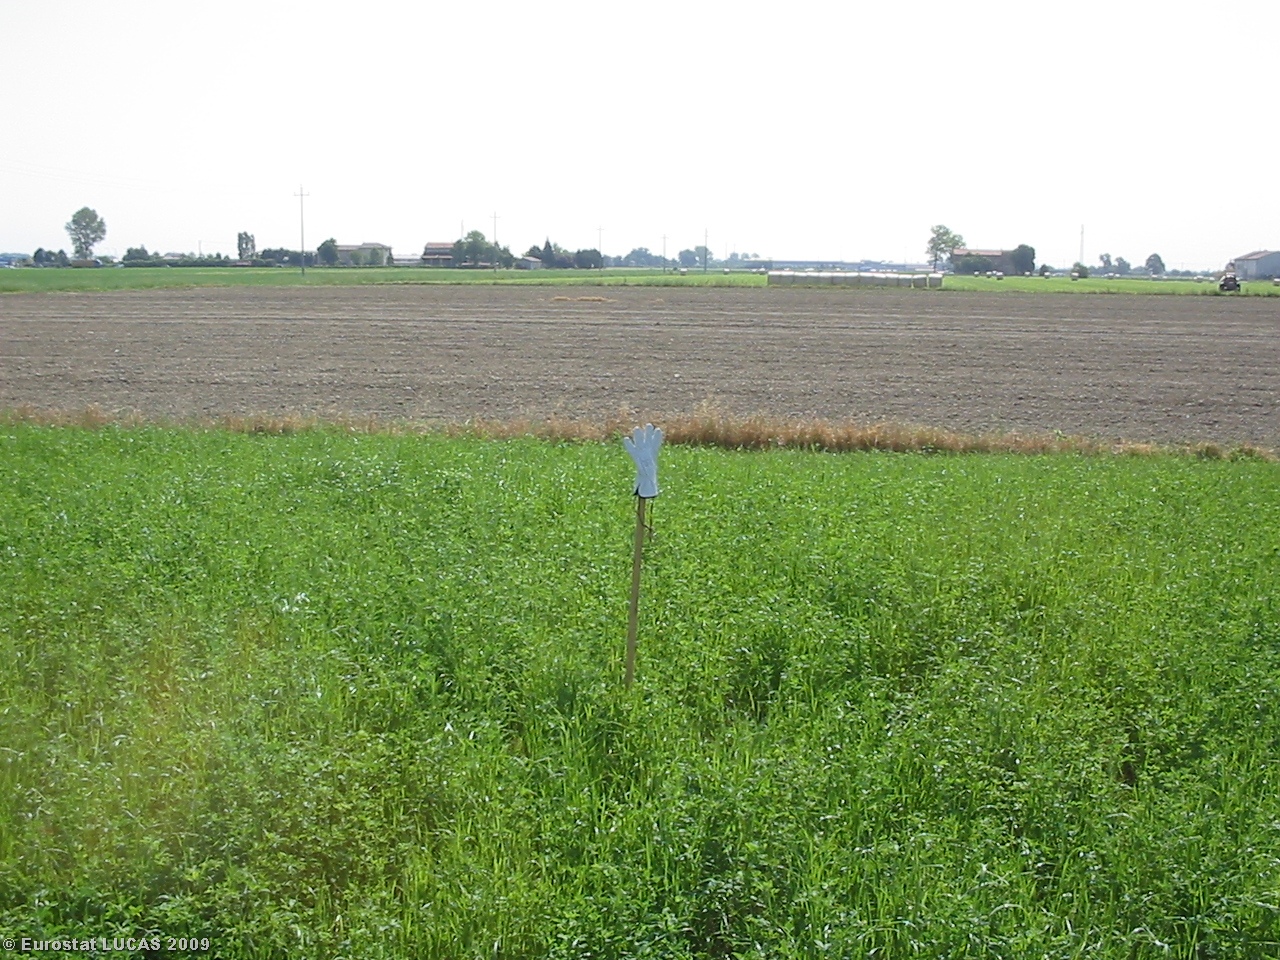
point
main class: Cropland
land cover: Lucerne
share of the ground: > 75 %
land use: Agriculture (excluding fallow land and kitchen gardens)
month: May
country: IT
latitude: 44.8730
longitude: 10.3411
